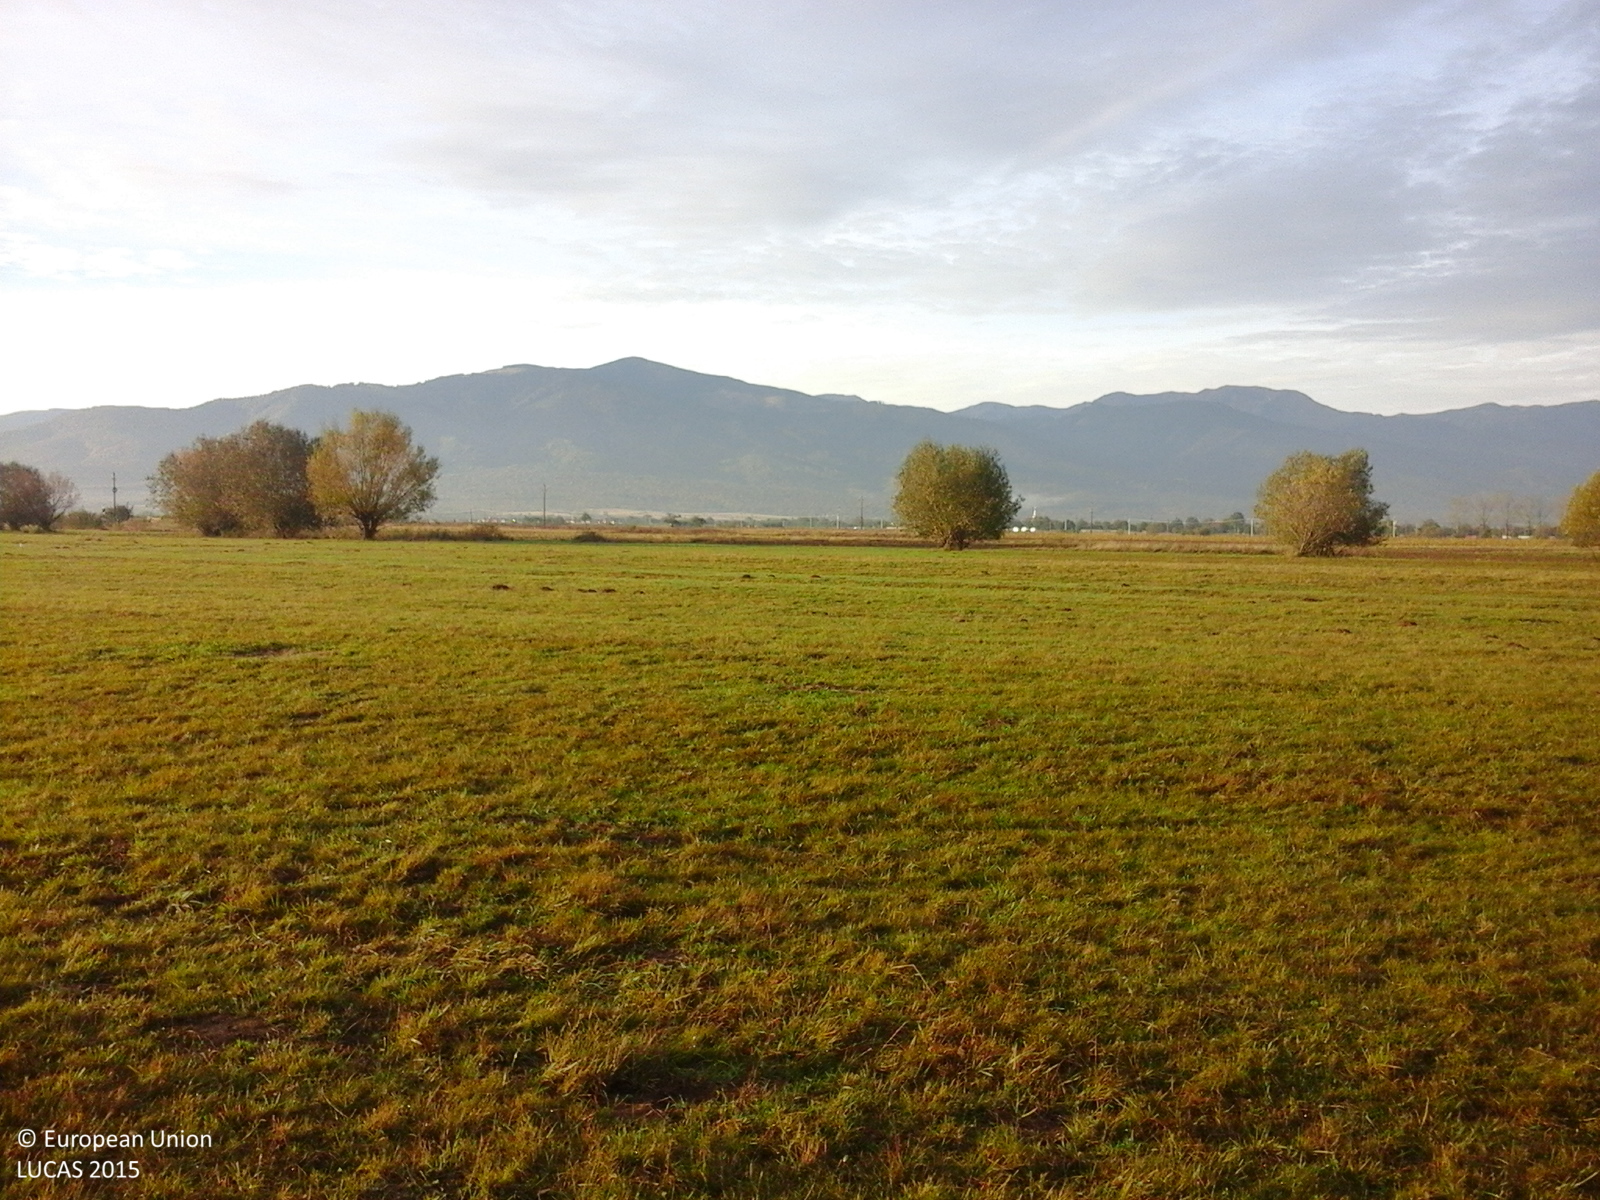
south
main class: Grassland
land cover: Grassland without tree/shrub cover
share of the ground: > 75 %
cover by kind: herbaceous plants 100 %
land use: Agriculture (excluding fallow land and kitchen gardens)
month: October
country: RO
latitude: 45.7380
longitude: 25.0393
